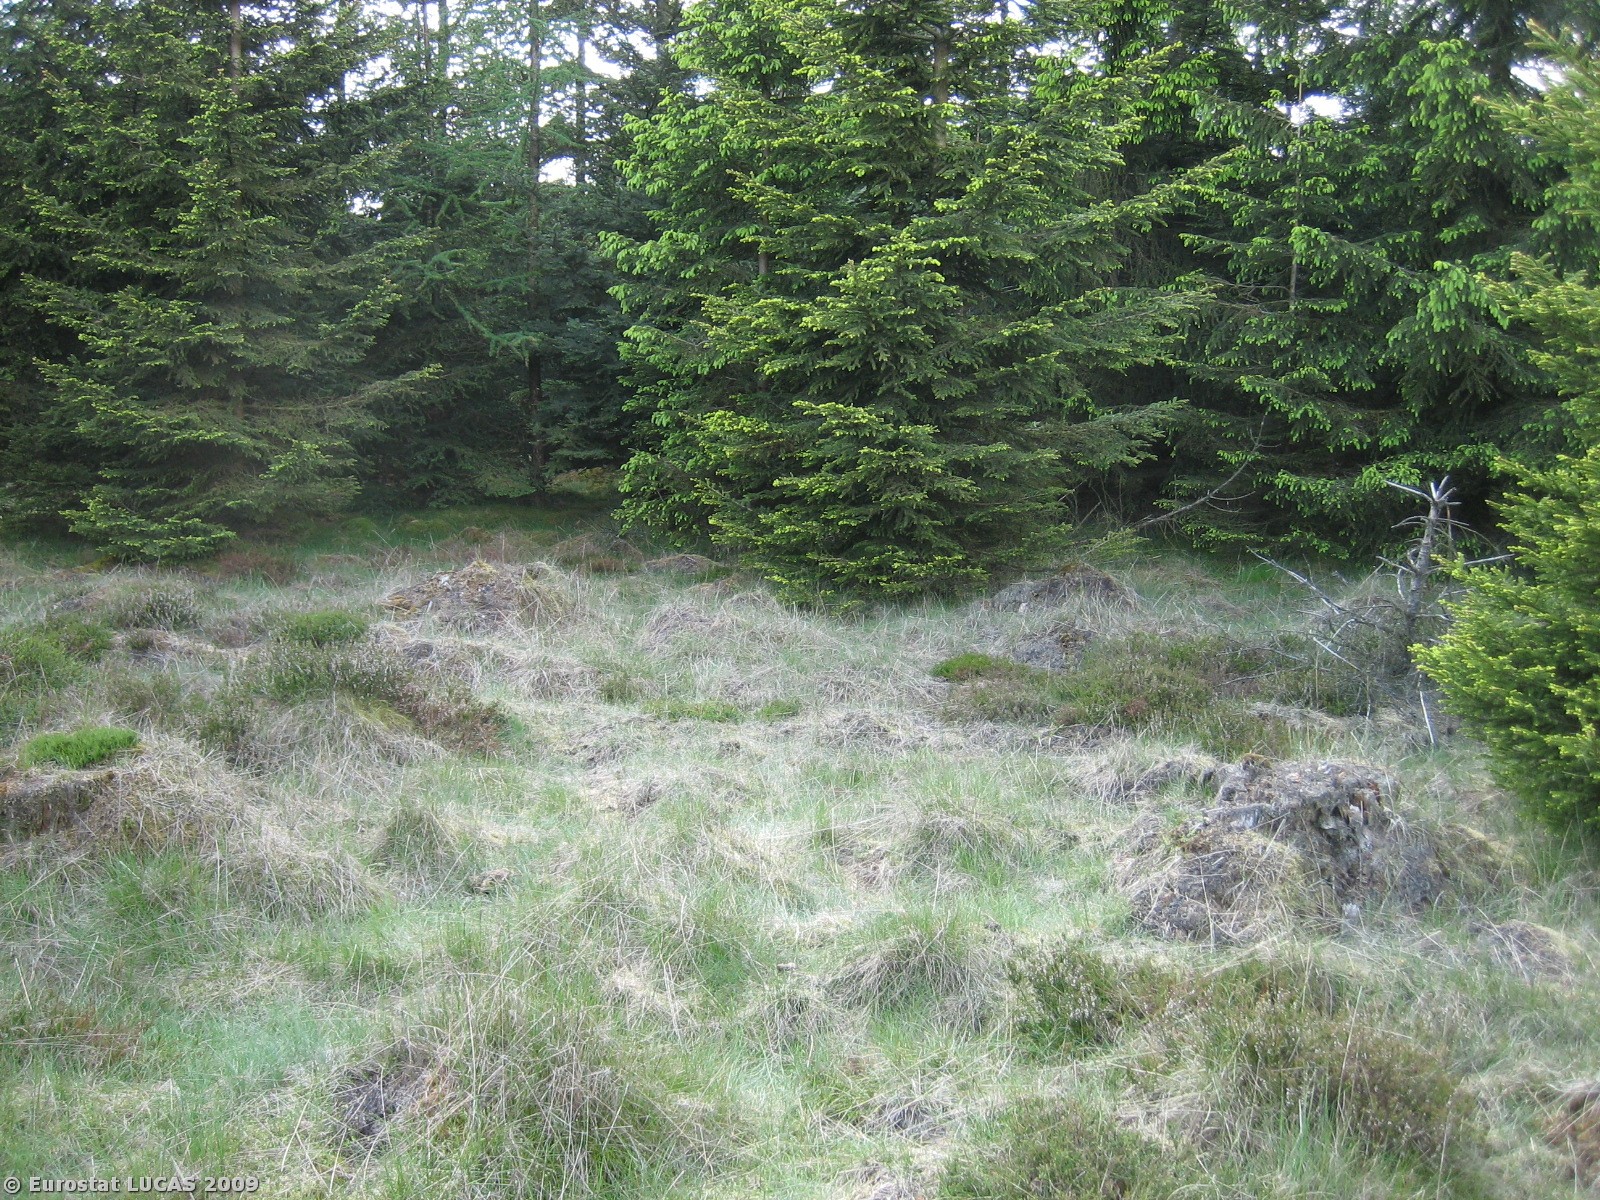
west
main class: Shrubland
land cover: Shrubland with sparse tree cover
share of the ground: > 75 %
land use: Forestry
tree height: > 5 m
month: May
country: DK
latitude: 56.0574
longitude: 8.9253
